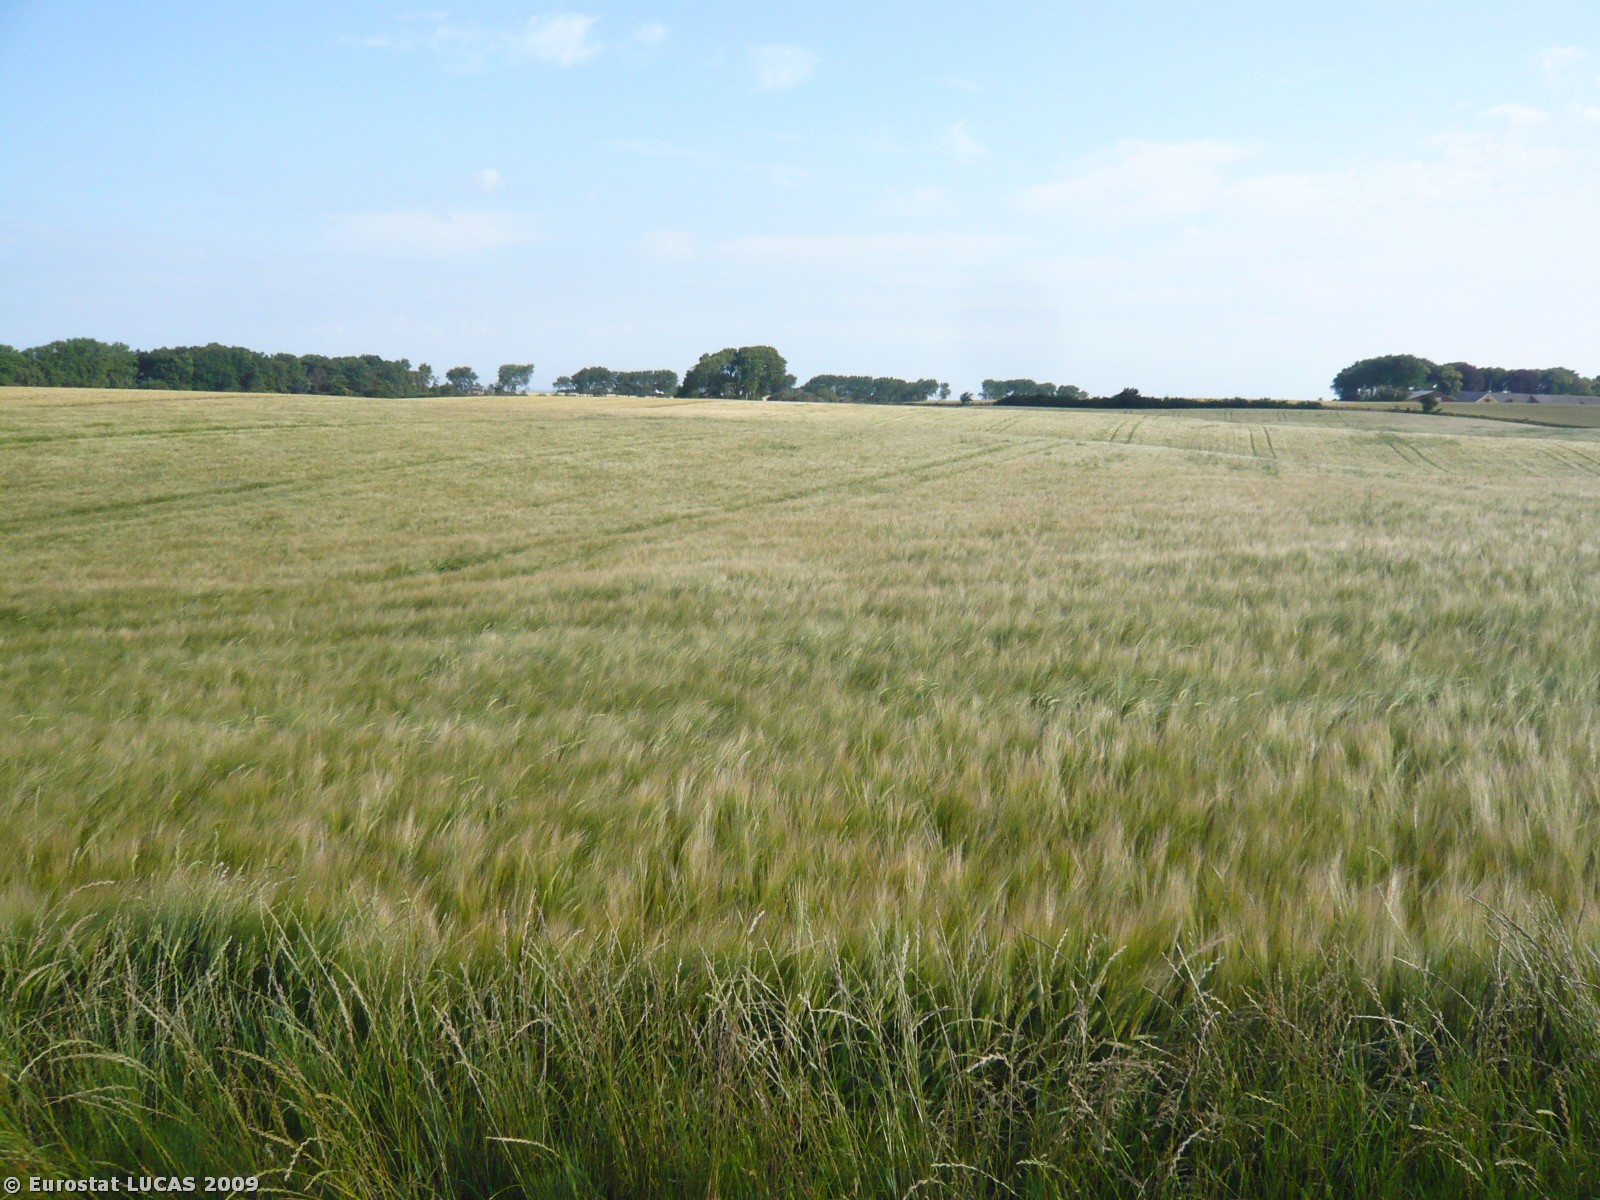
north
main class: Cropland
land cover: Common wheat
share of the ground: > 75 %
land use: Agriculture (excluding fallow land and kitchen gardens)
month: July
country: DK
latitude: 55.7325
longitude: 11.2250
